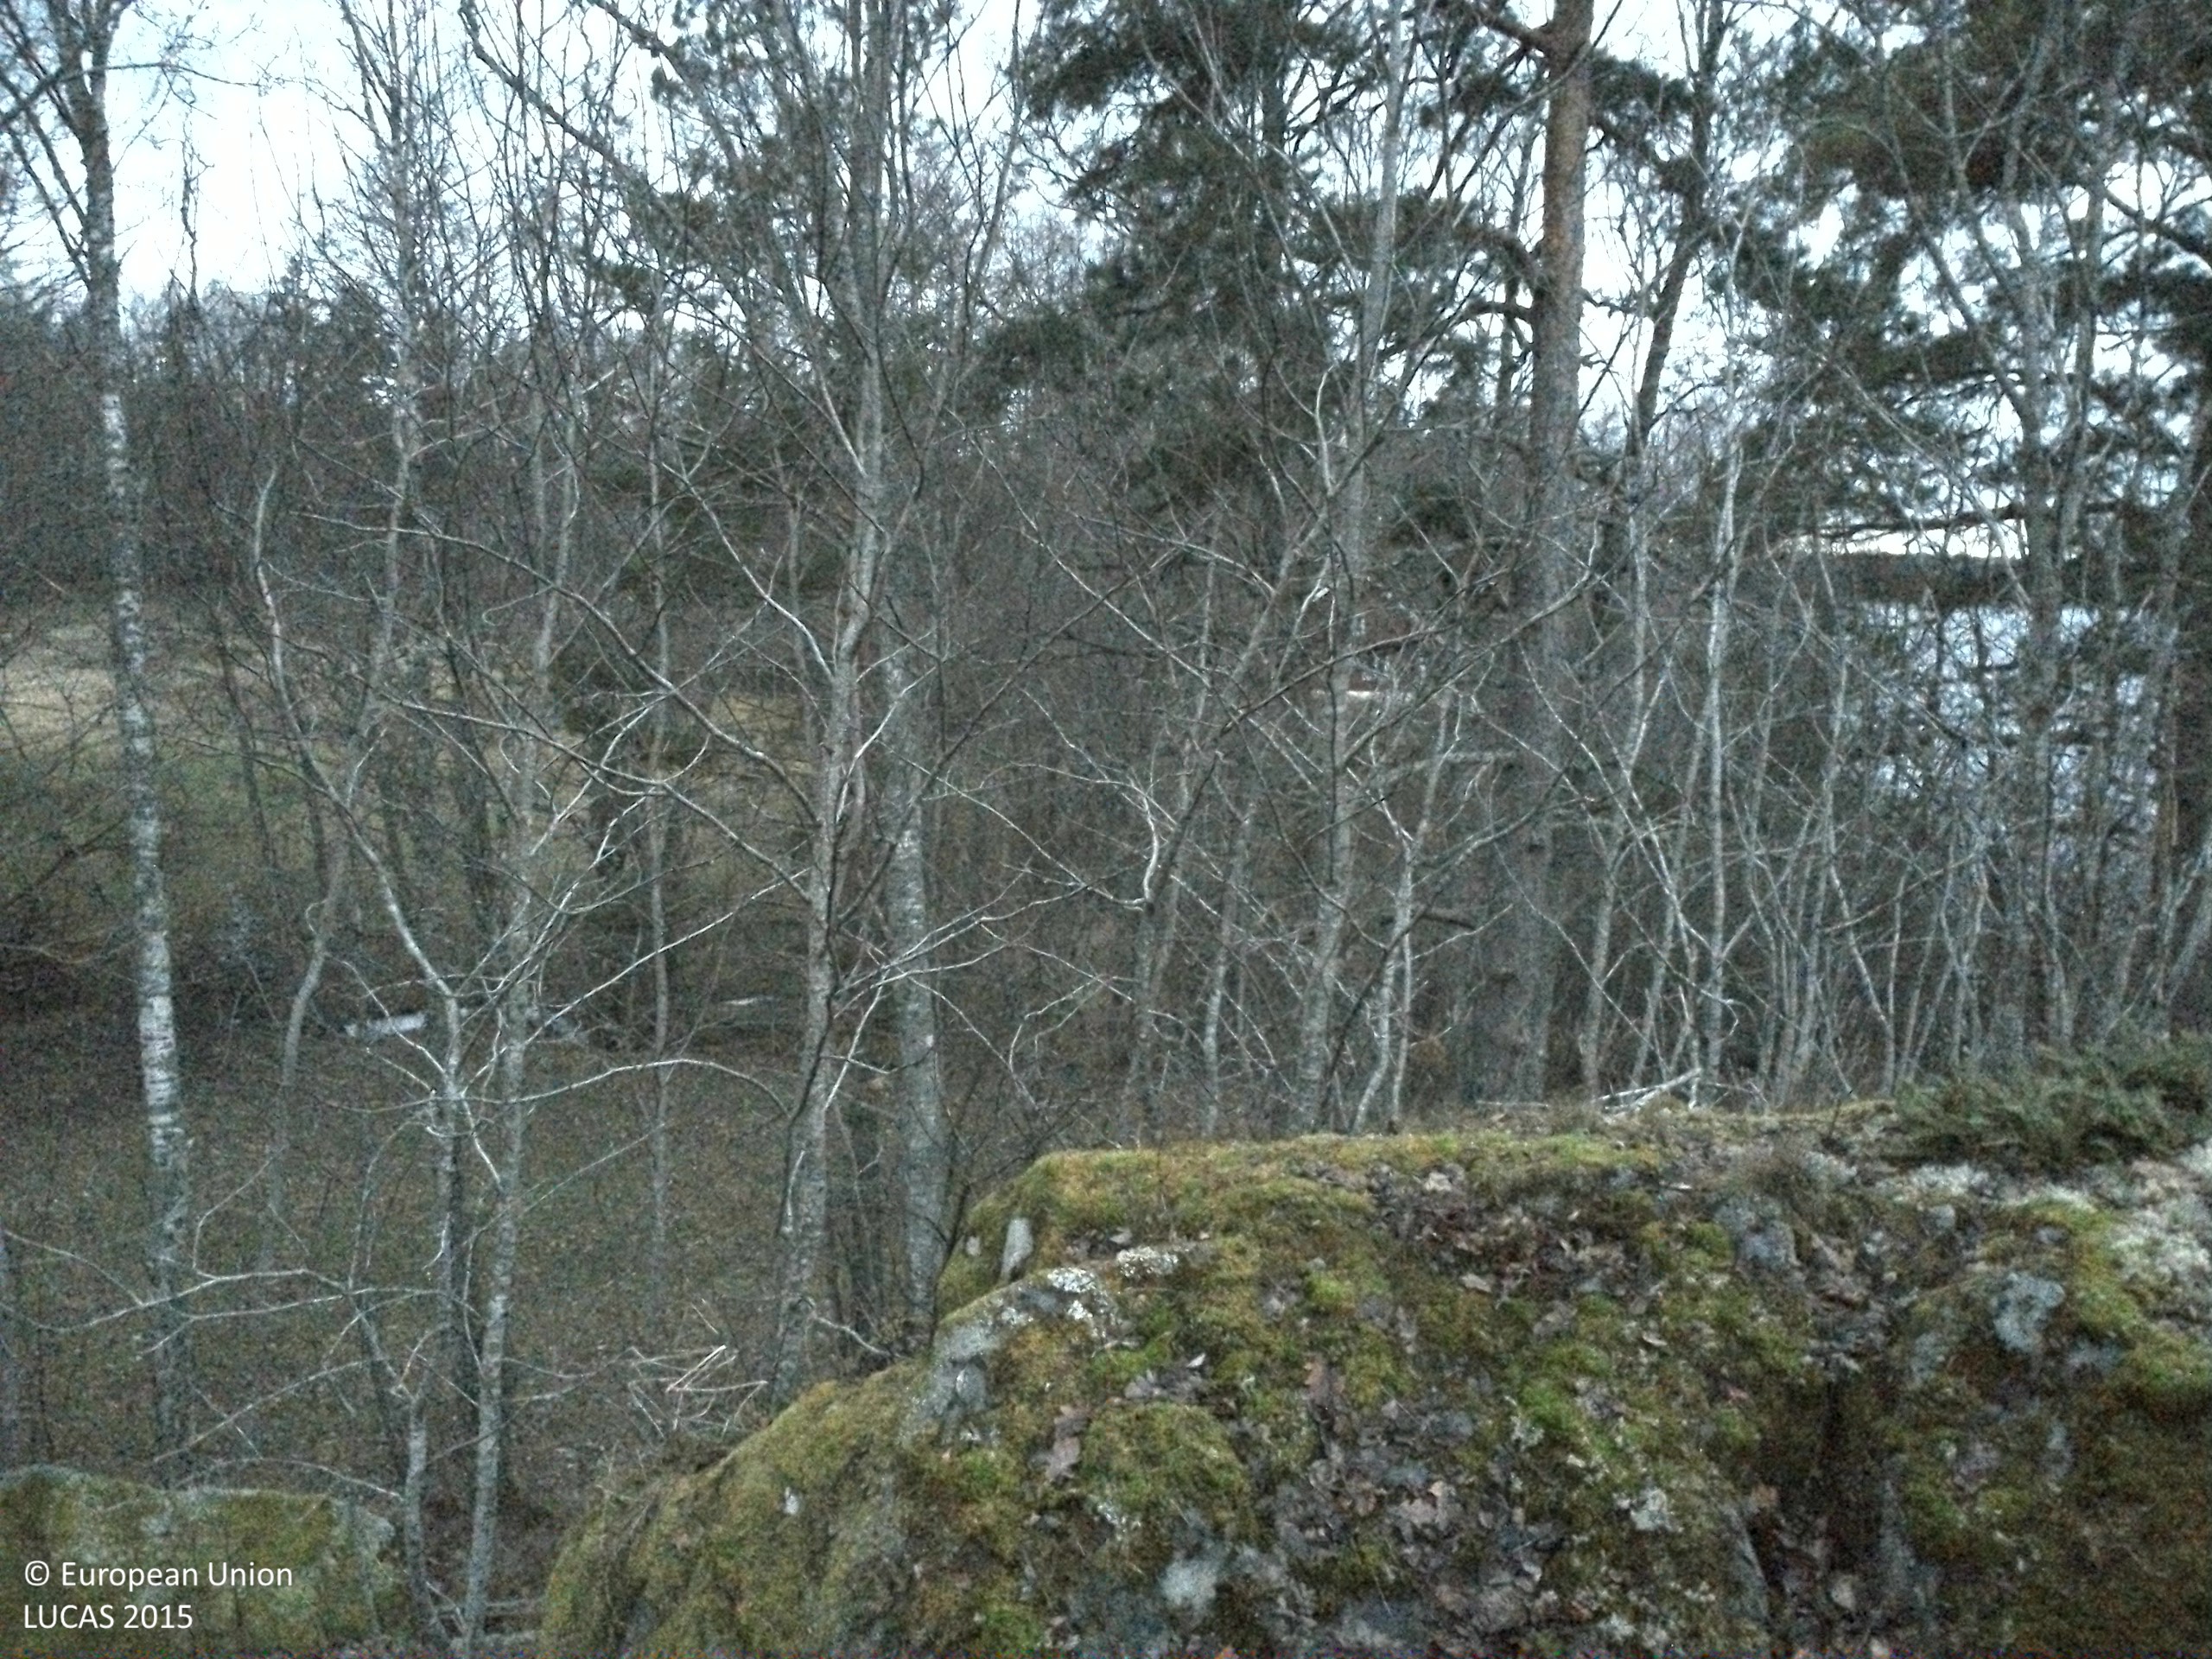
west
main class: Woodland
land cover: Broadleaved woodland
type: boreal forest
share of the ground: 25 - 50 %
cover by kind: consolidated bare surface 40 %, broadleaved forest trees 35 %, coniferous forest trees 10 %, lichens and mosses 10 %, herbaceous plants 5 %
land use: Semi-natural and natural areas not in use
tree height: > 5 m
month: December
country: SE
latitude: 59.2249
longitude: 17.0915
